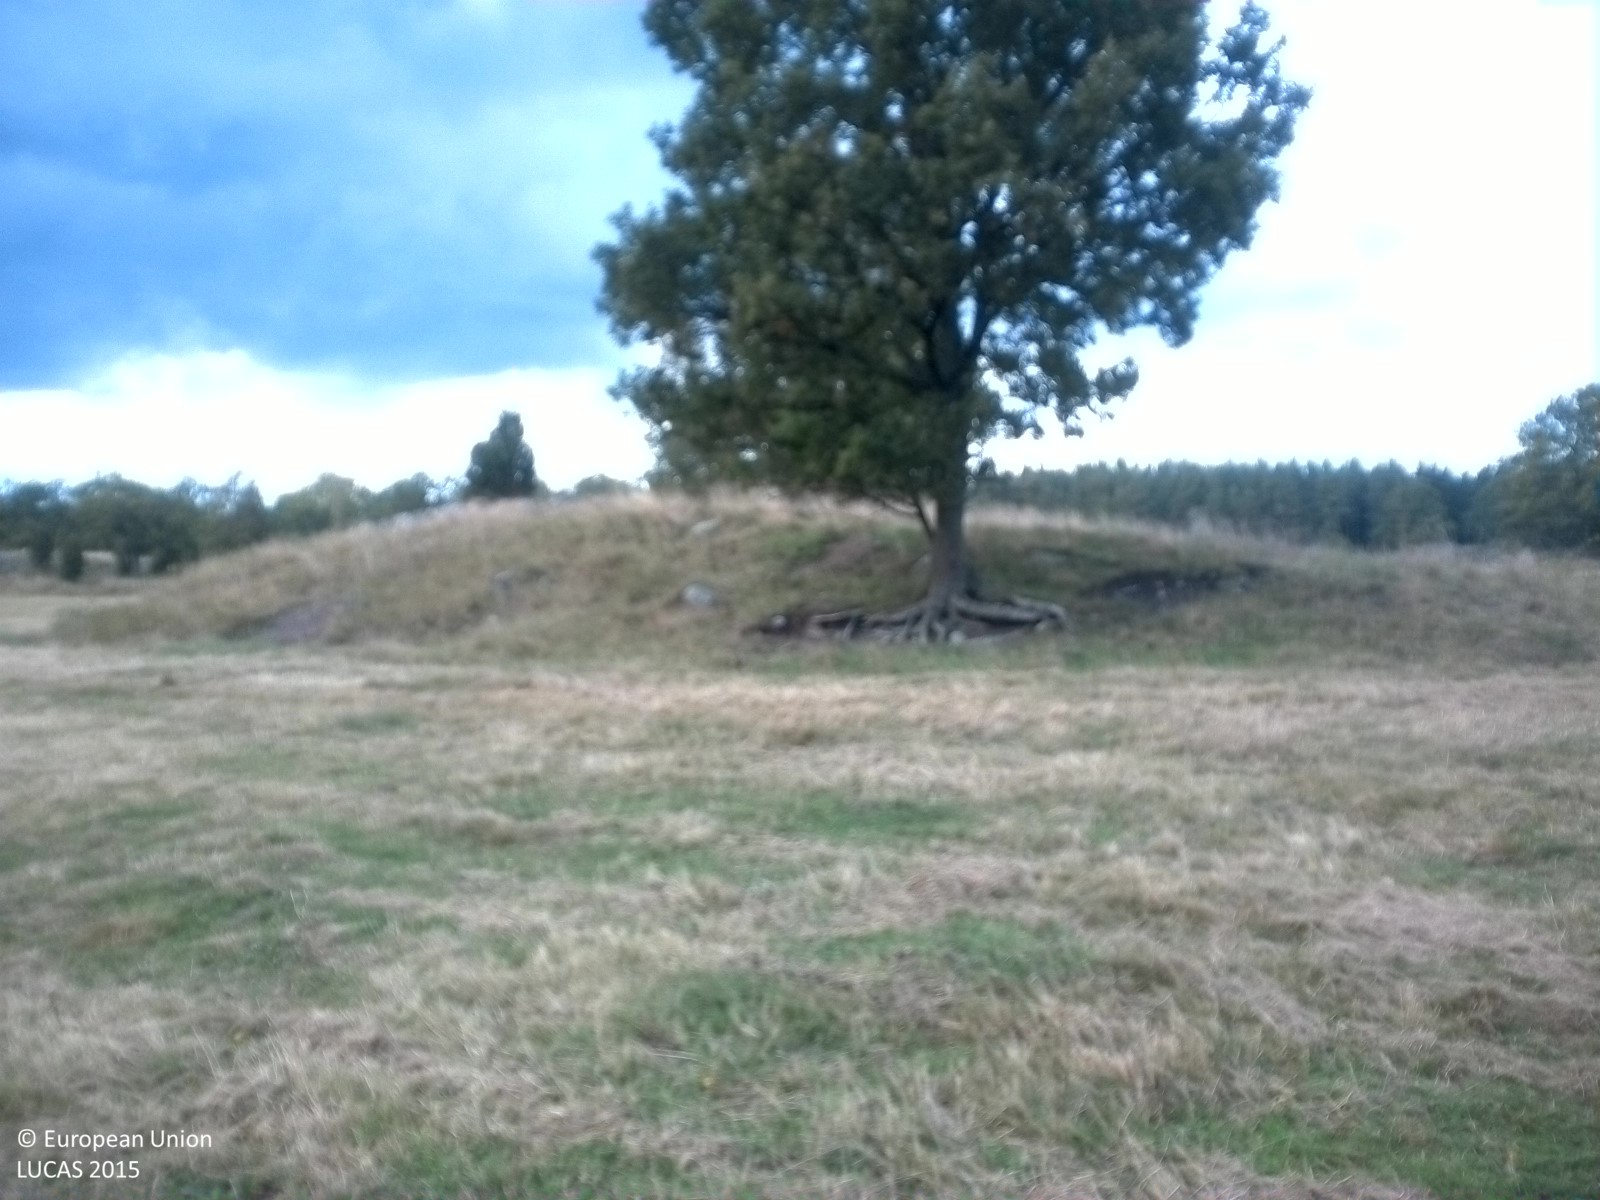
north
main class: Grassland
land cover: Grassland without tree/shrub cover
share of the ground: > 75 %
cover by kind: herbaceous plants 100 %
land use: Agriculture (excluding fallow land and kitchen gardens)
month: September
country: SE
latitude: 58.5930
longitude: 16.7235
